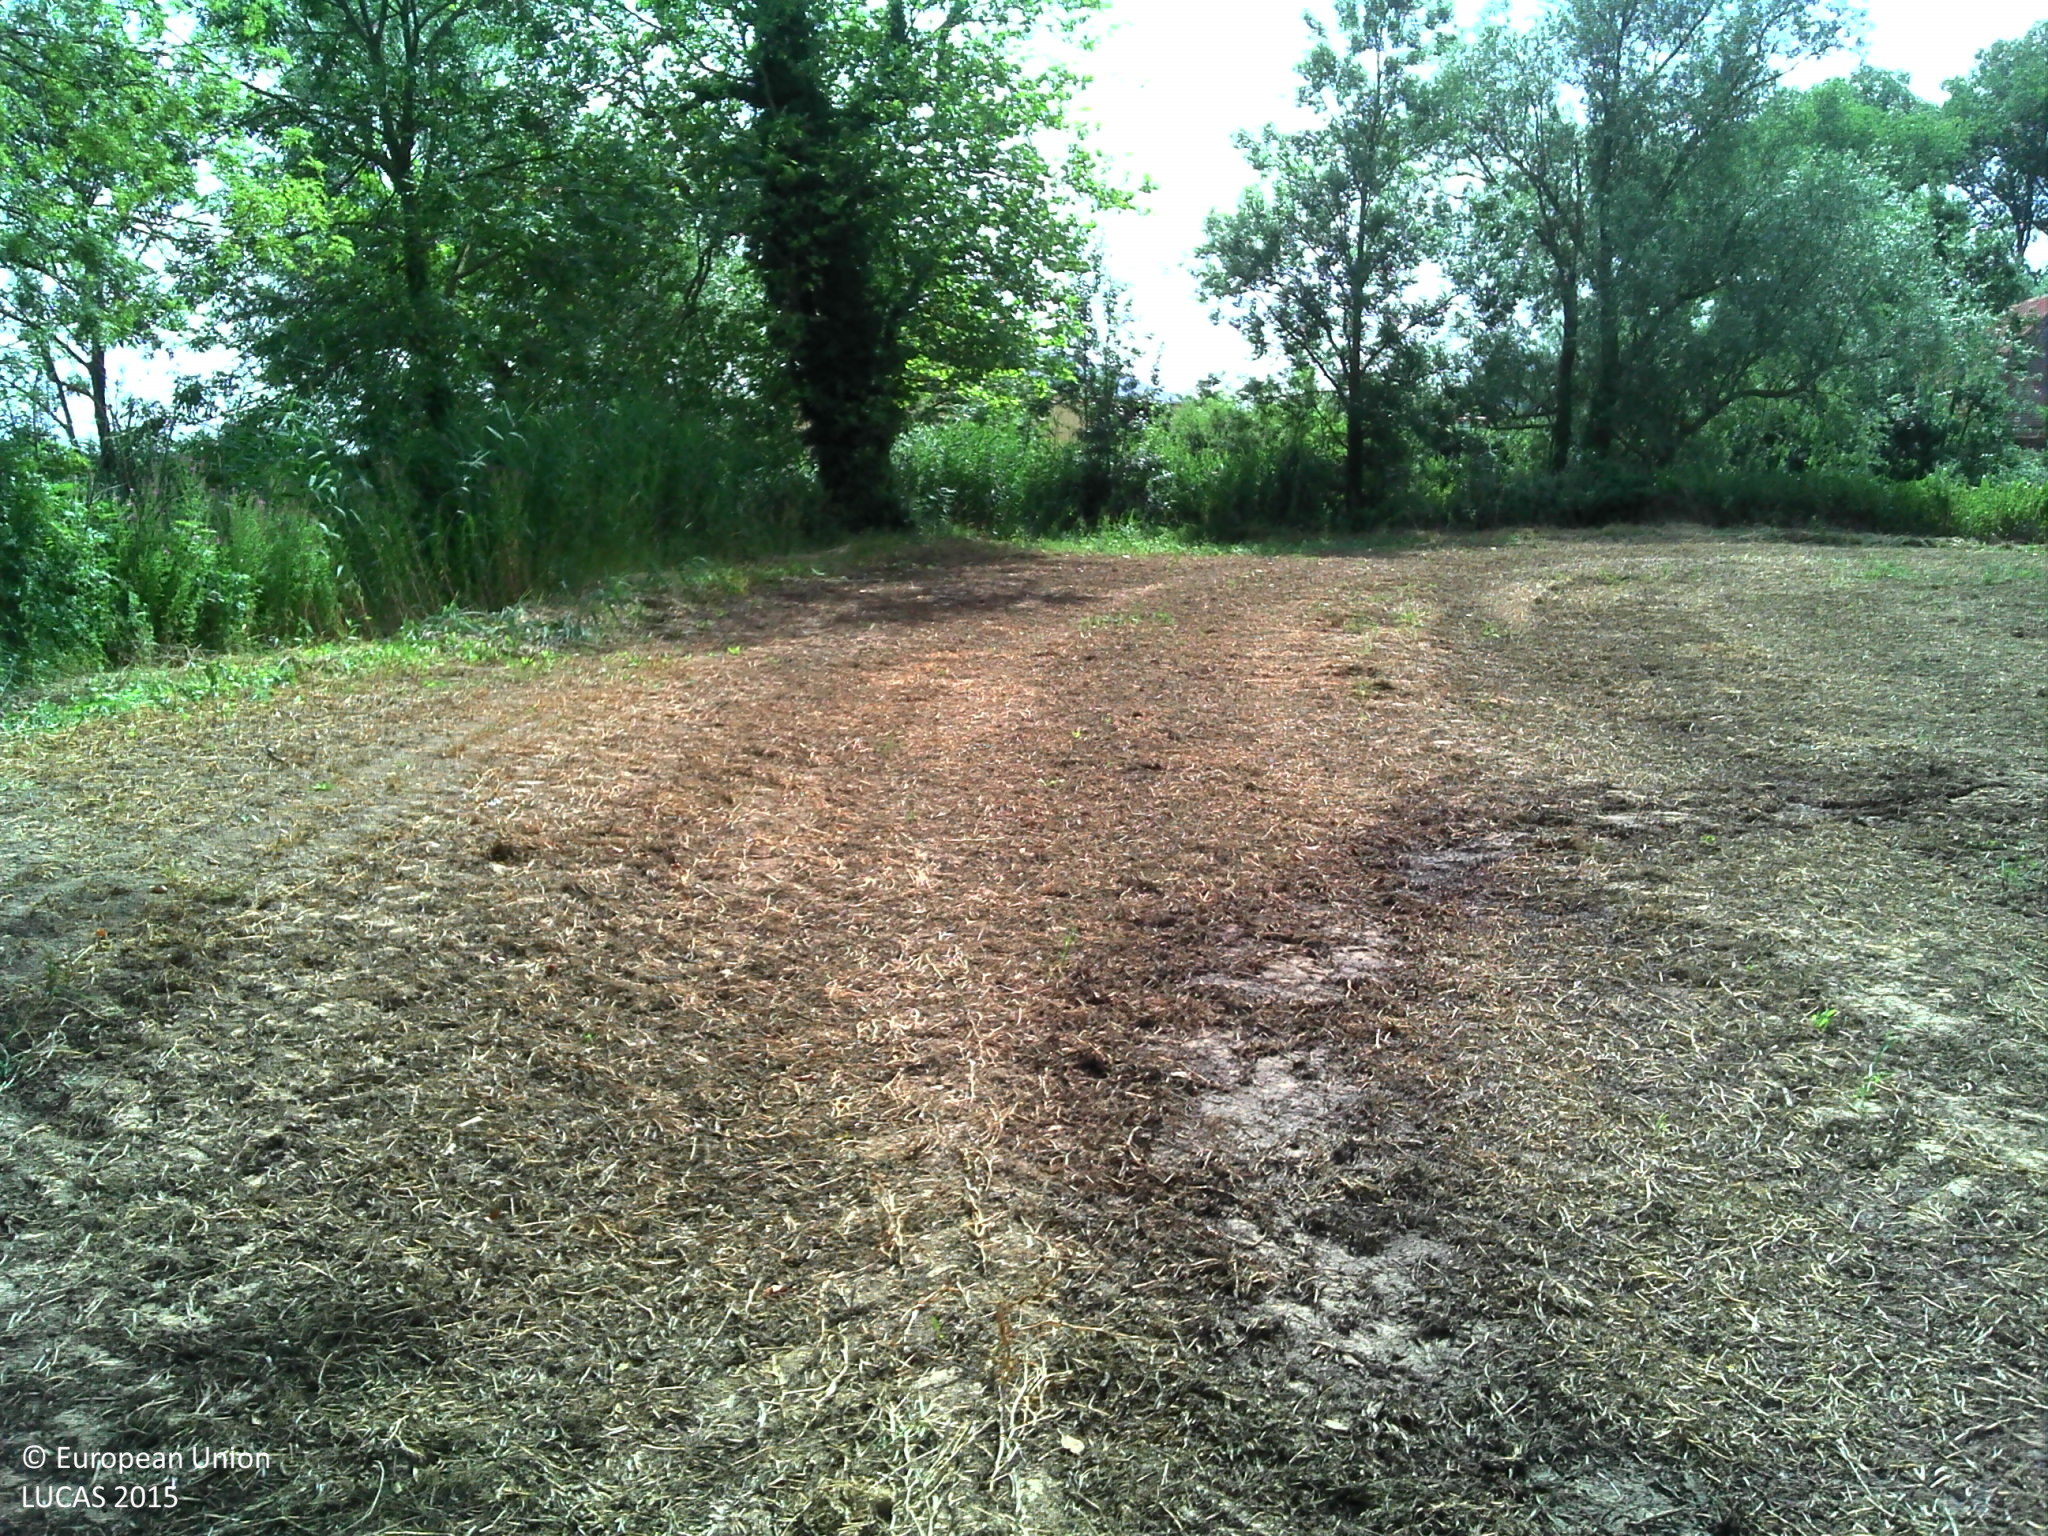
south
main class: Cropland
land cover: Dry pulses
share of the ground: < 10 %
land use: Agriculture (excluding fallow land and kitchen gardens)
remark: Harvested field
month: July
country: FR
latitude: 50.7971
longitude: 2.3962
